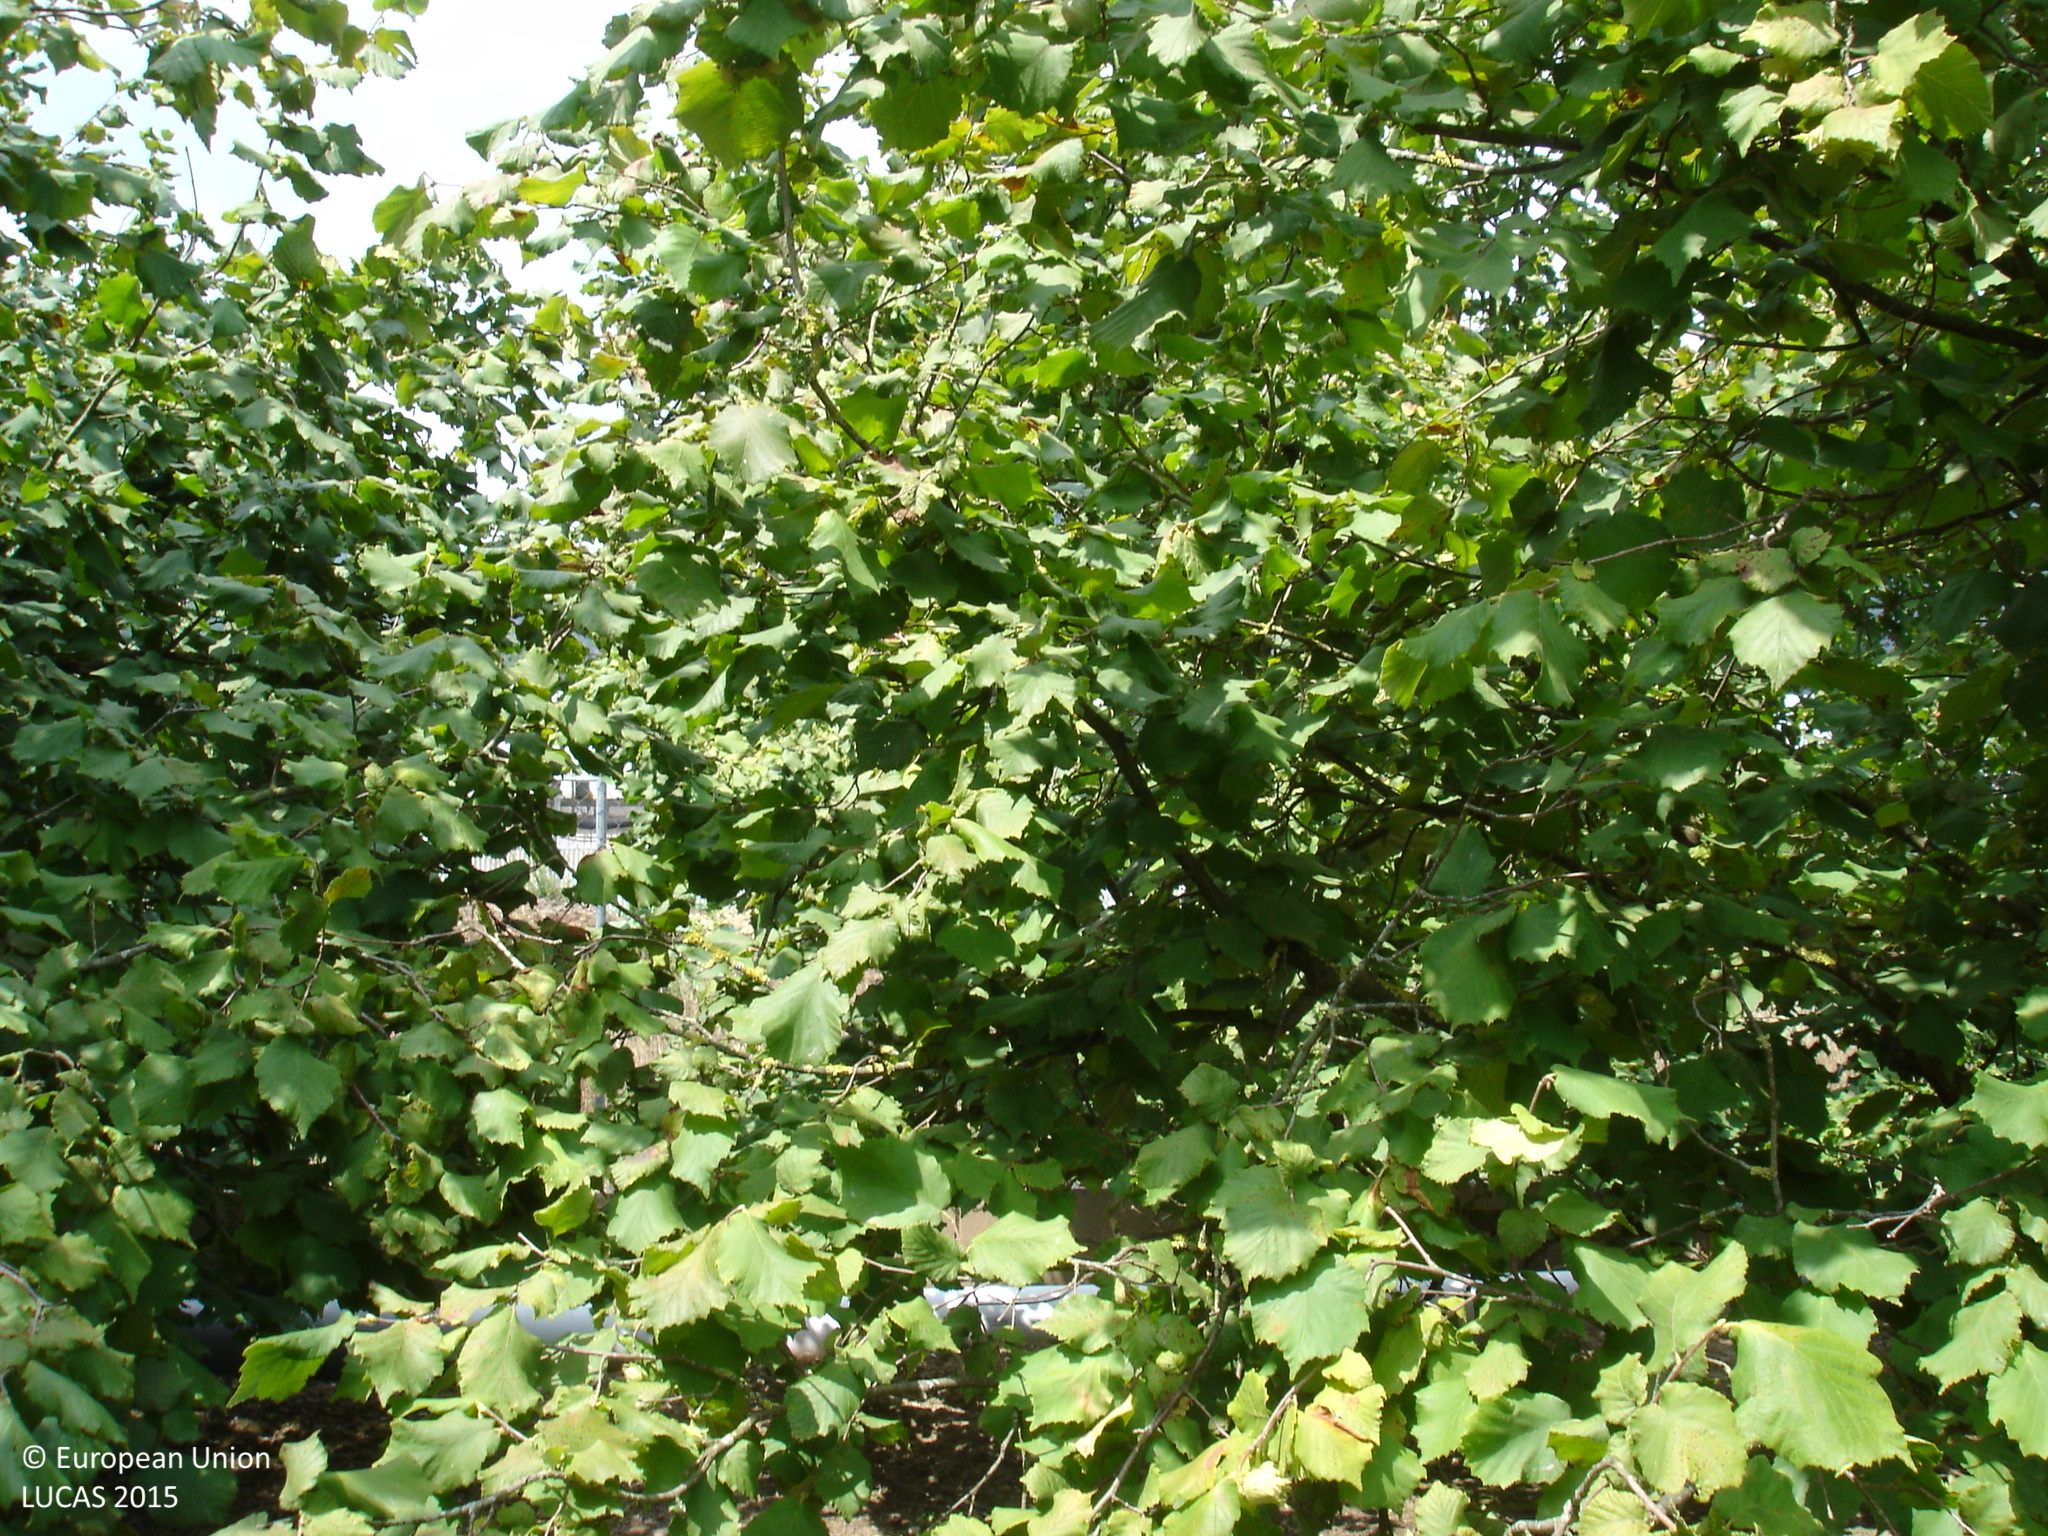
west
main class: Cropland
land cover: Nuts trees
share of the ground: 50 - 75 %
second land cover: Other bare soil
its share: > 75 %
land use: Agriculture (excluding fallow land and kitchen gardens)
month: July
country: ES
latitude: 41.9854
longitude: 2.6163
